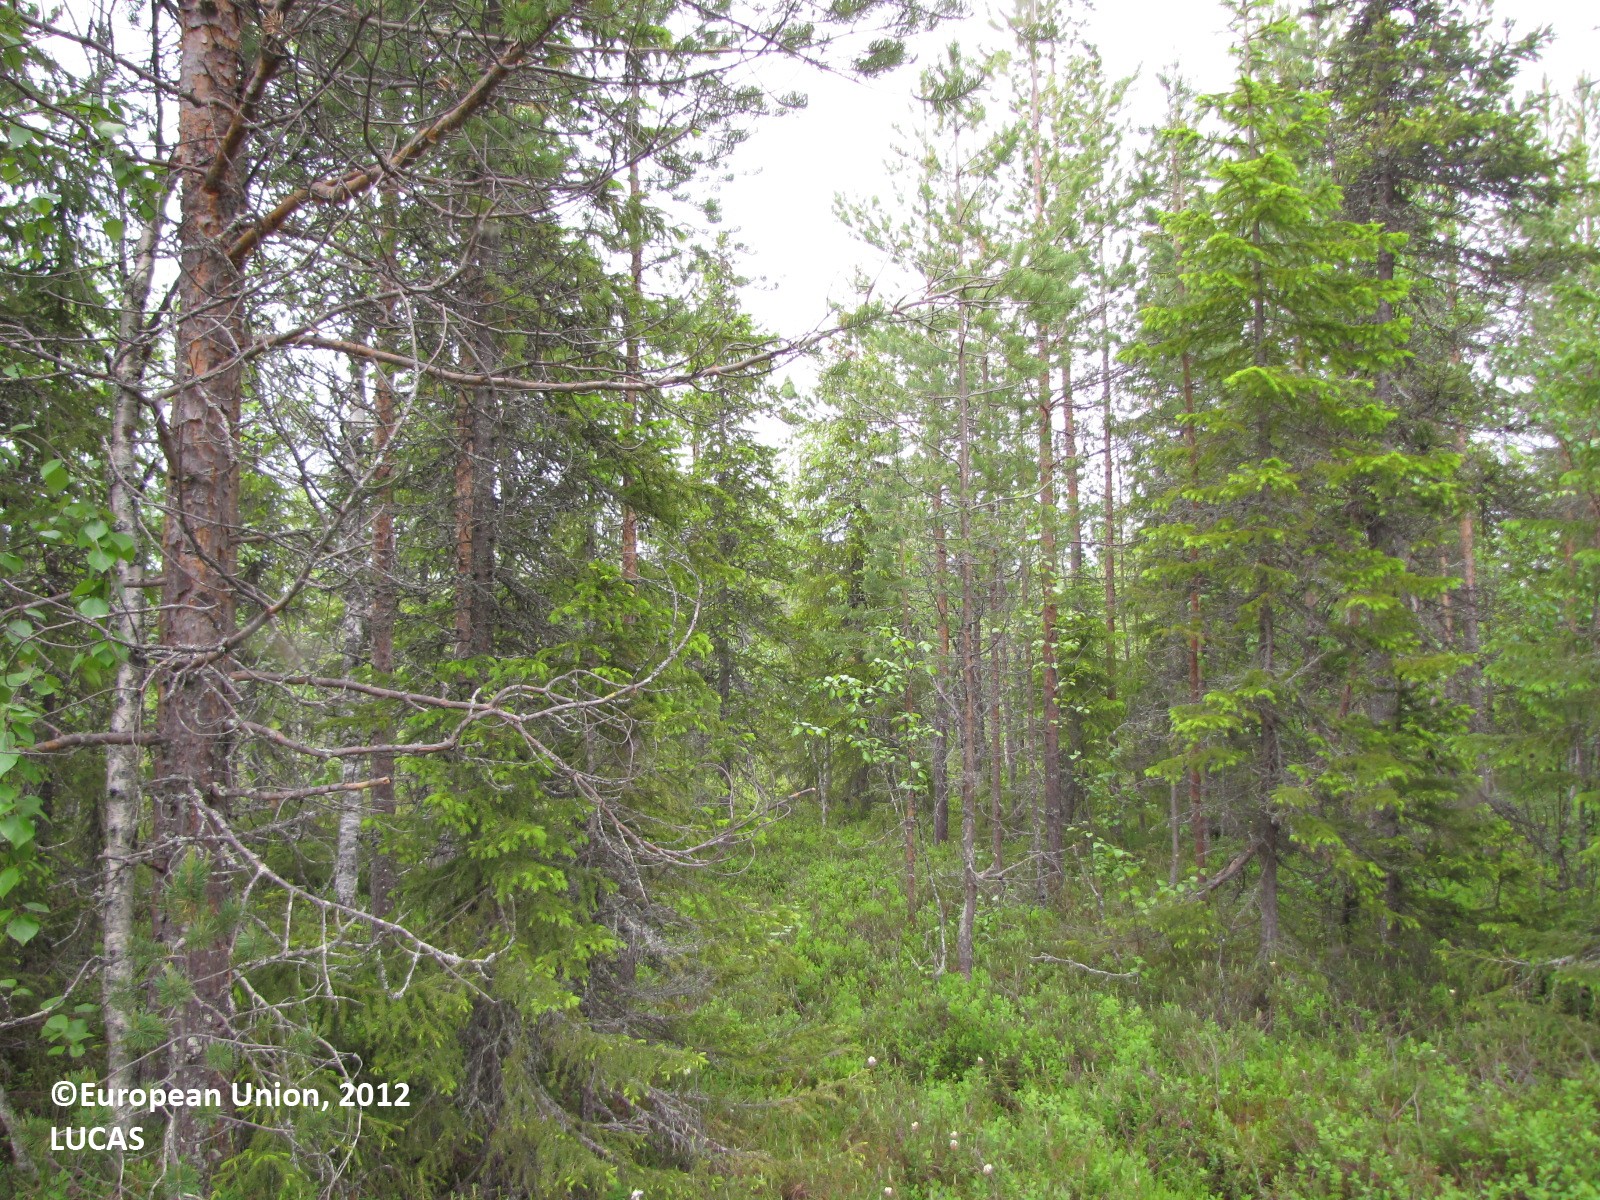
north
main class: Woodland
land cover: Other mixed woodland
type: boreal forest
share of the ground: 50 - 75 %
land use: Forestry
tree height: > 5 m
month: June
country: FI
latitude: 66.1278
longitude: 24.6902
